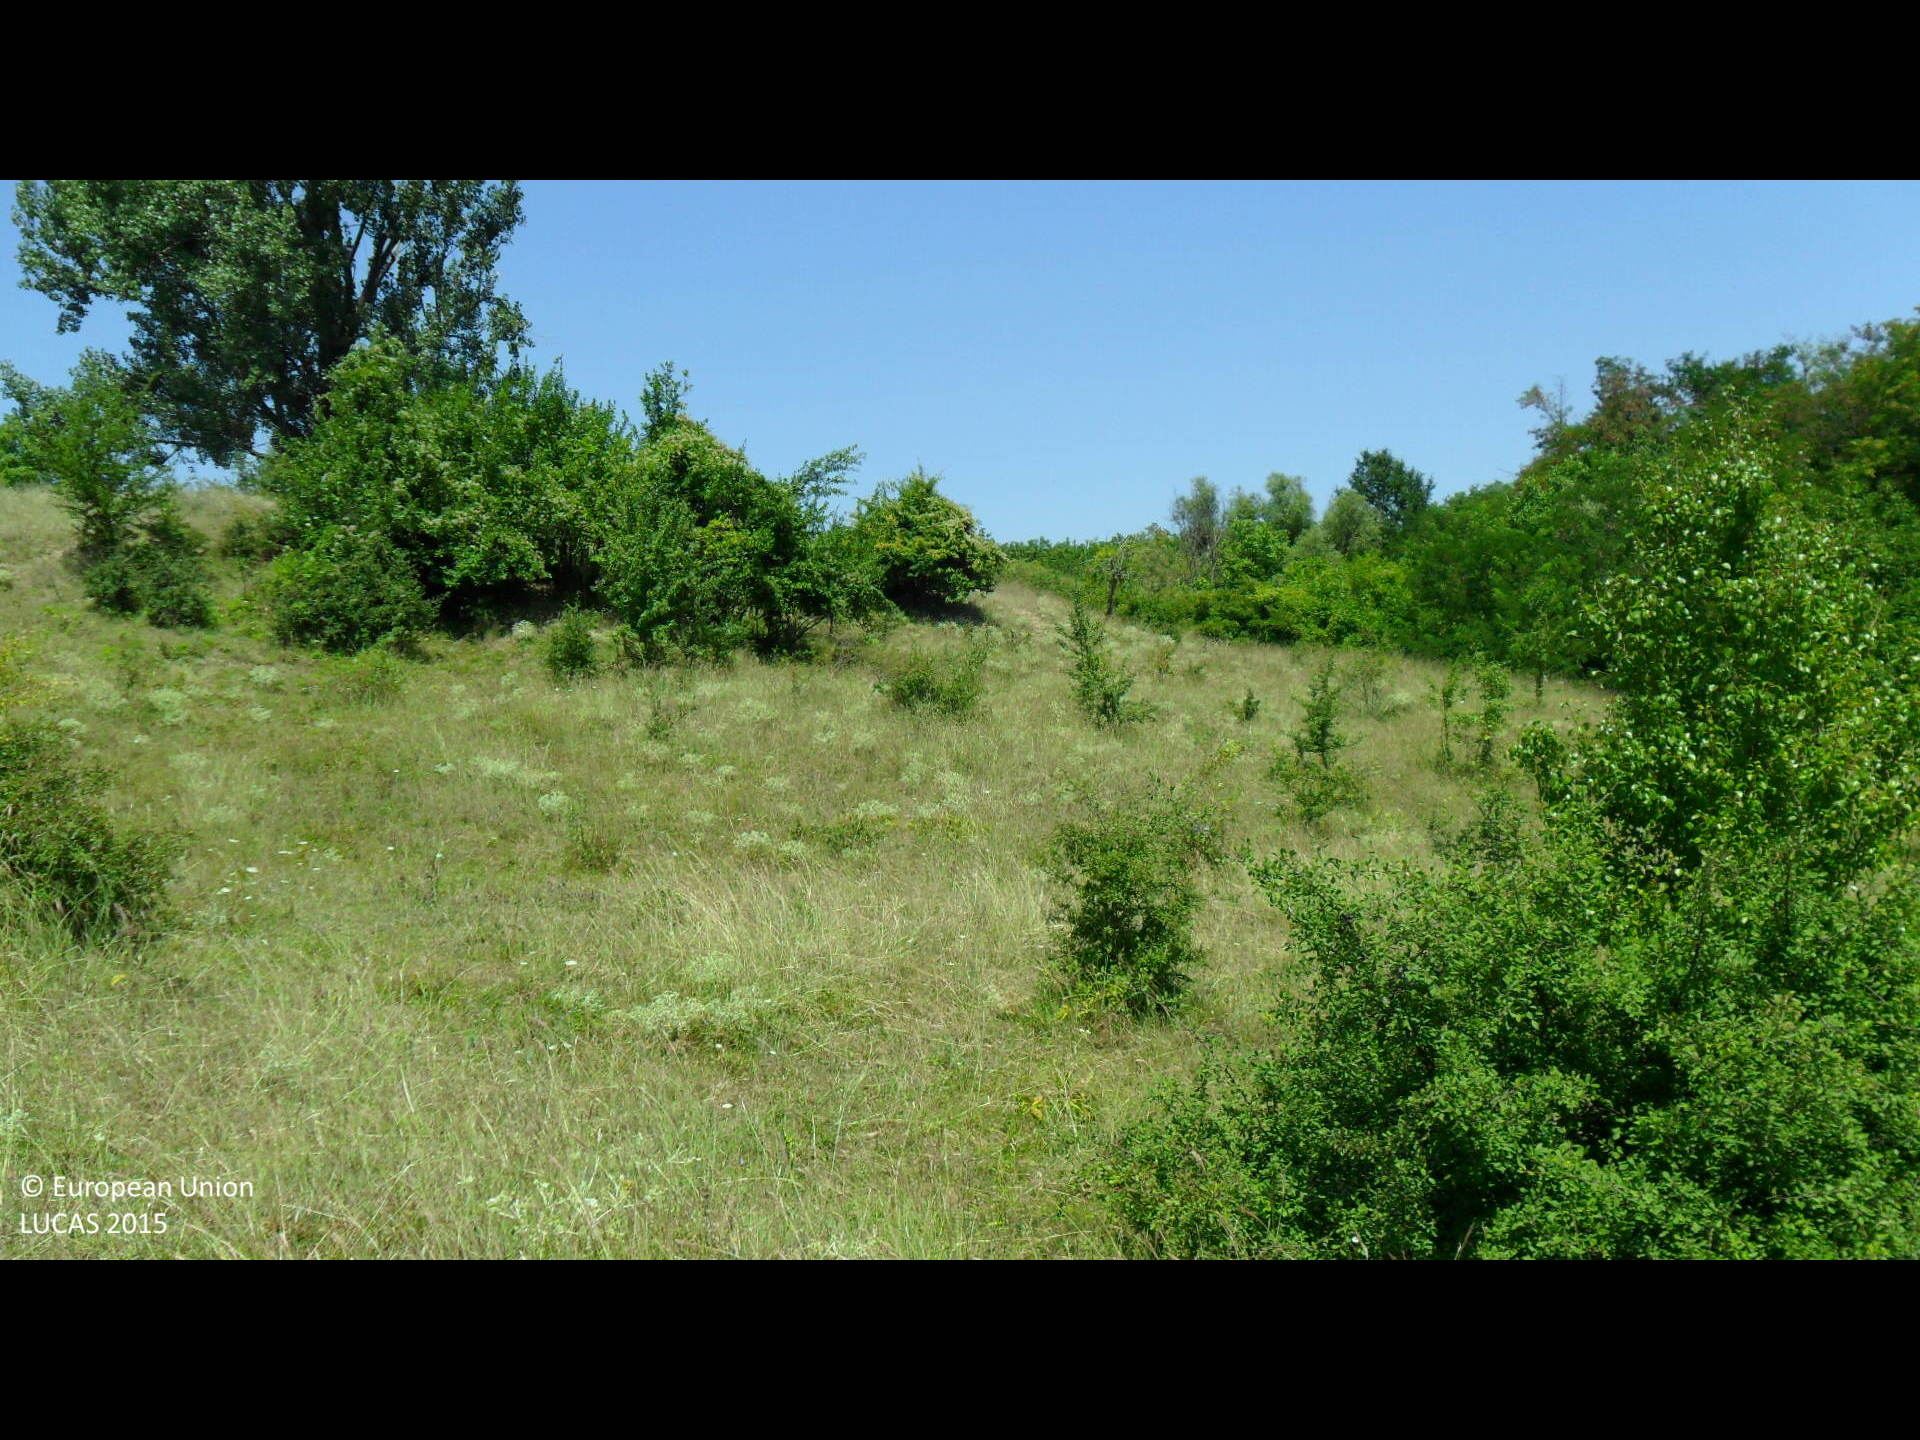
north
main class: Grassland
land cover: Grassland with sparse tree/shrub cover
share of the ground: > 75 %
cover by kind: herbaceous plants 90 %, broadleaved forest trees 5 %, shrubs 5 %
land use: Agriculture (excluding fallow land and kitchen gardens)
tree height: > 5 m
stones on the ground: < 10 %
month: August
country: BG
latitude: 43.3204
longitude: 26.1112
